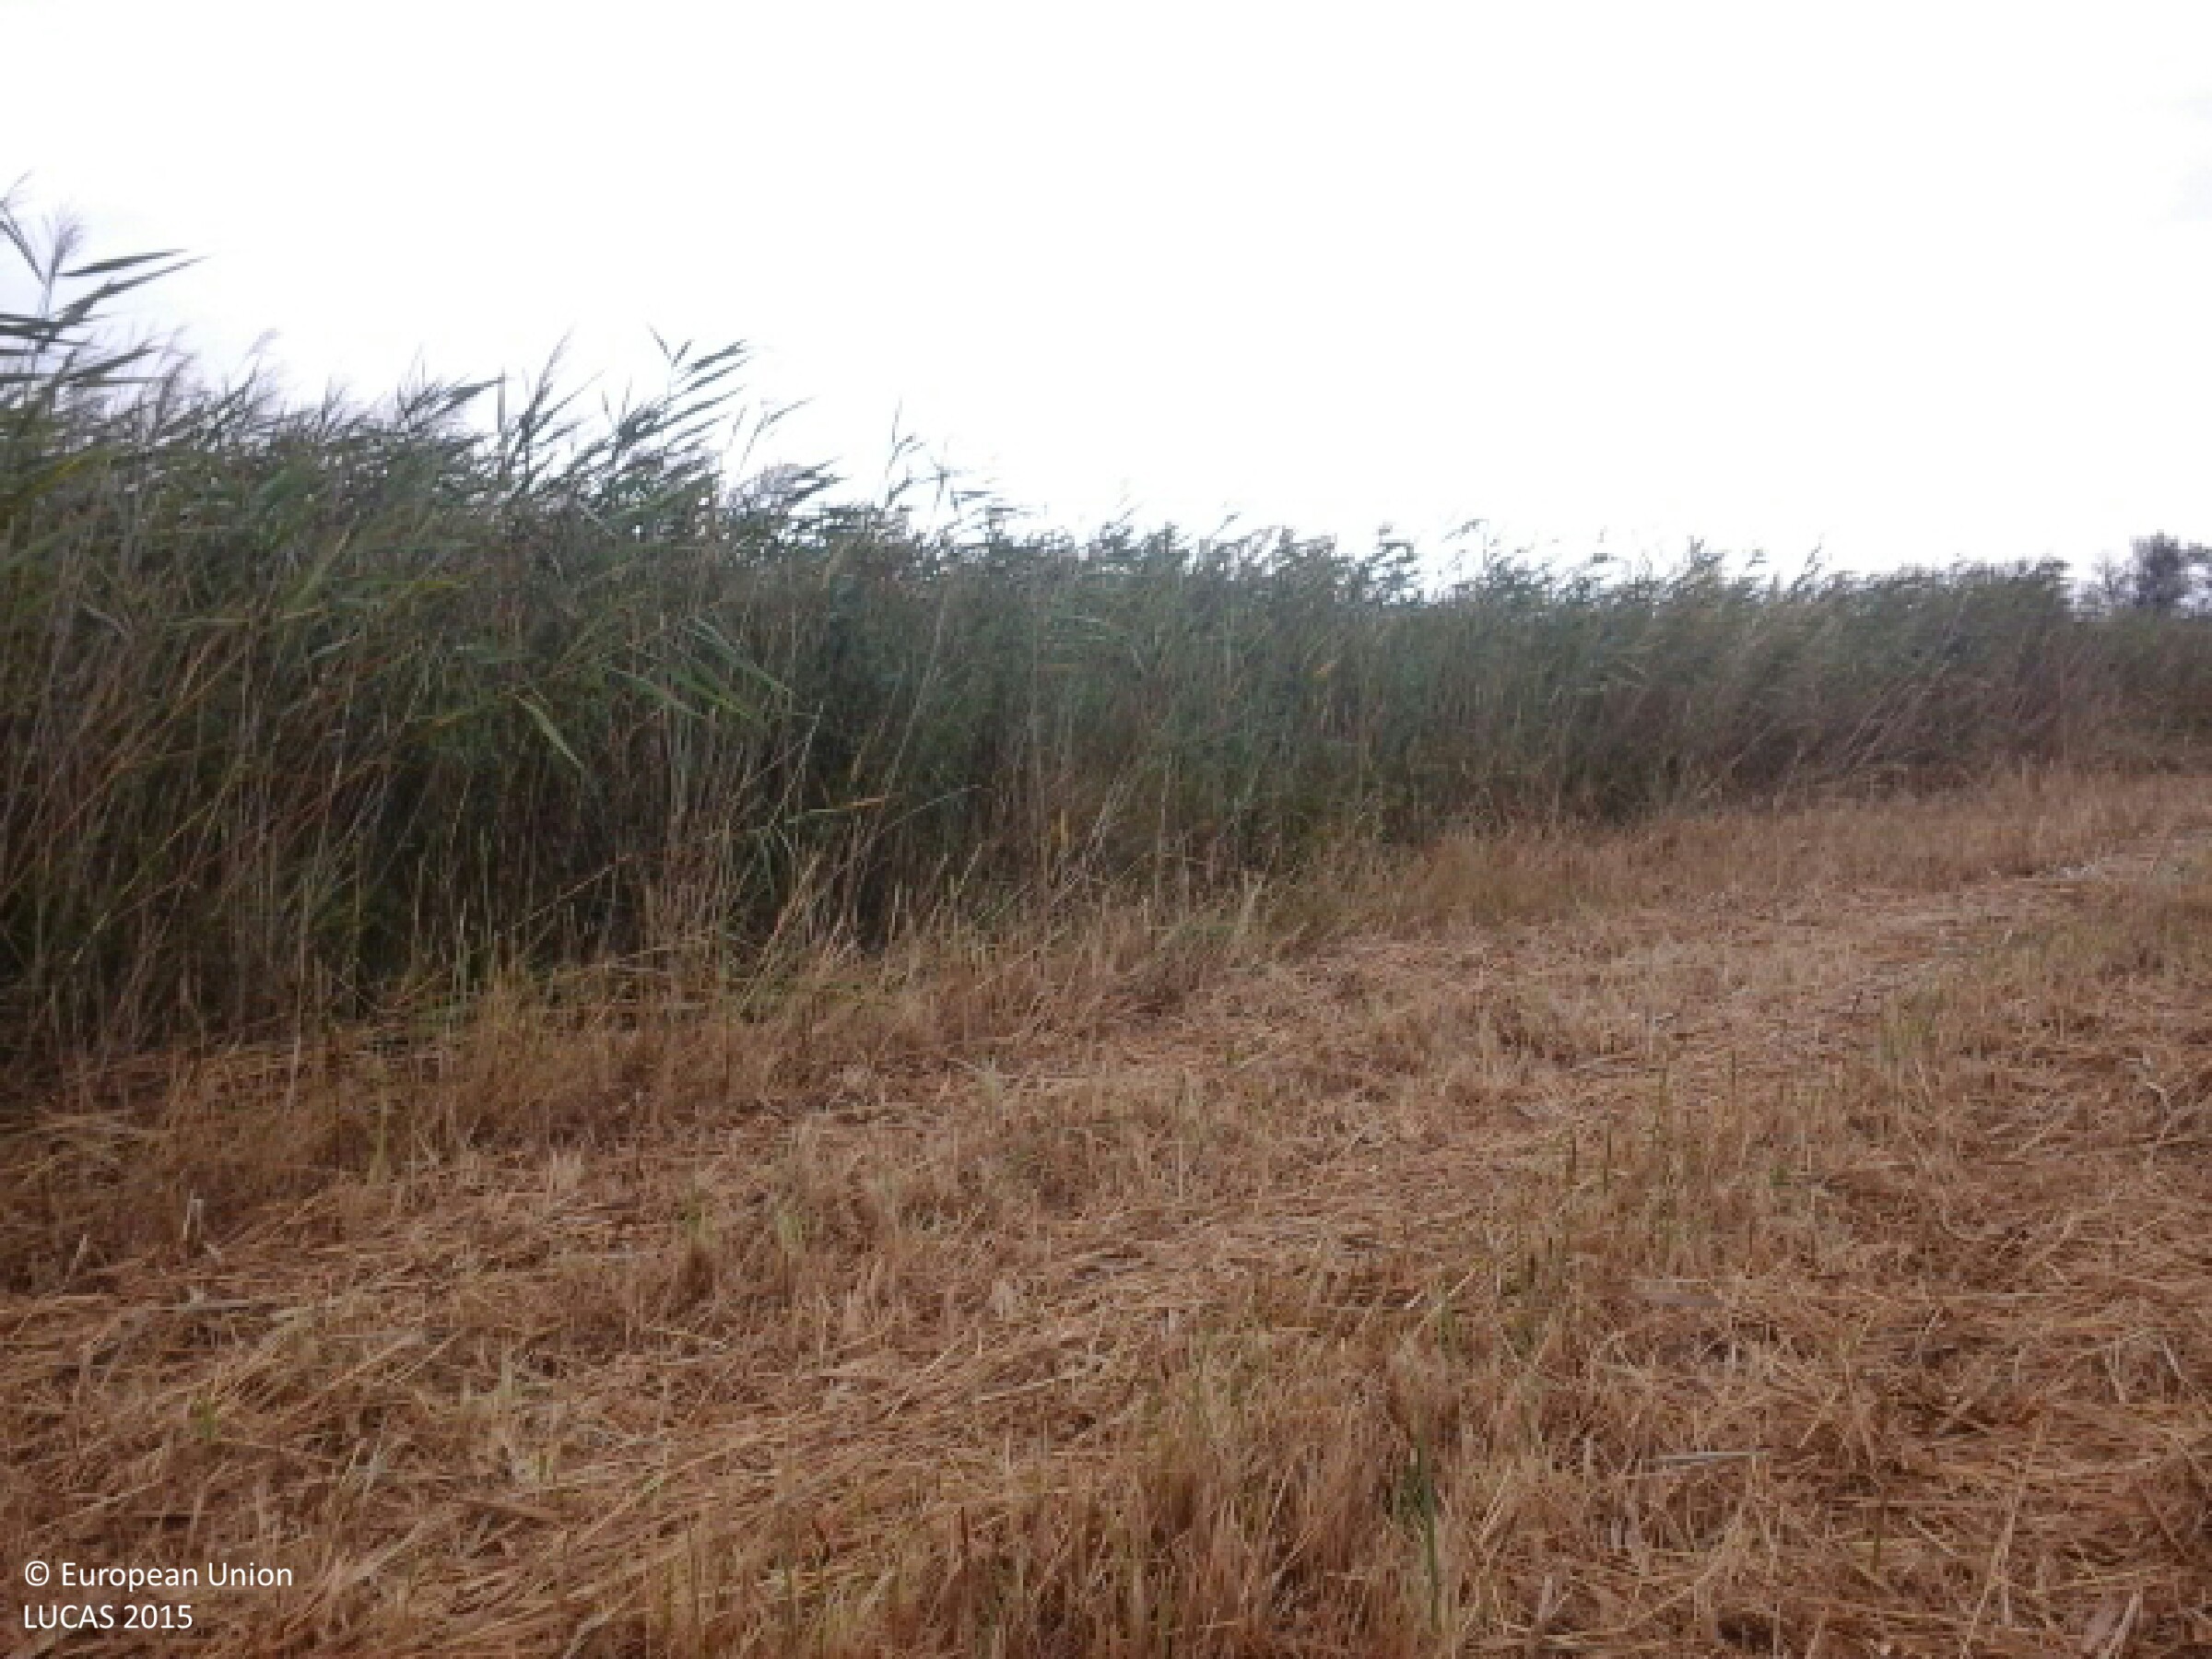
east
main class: Grassland
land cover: Grassland without tree/shrub cover
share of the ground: > 75 %
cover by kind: herbaceous plants 100 %
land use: Agriculture (excluding fallow land and kitchen gardens)
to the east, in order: Grassland without tree/shrub cover; Inland marshes; Grassland without tree/shrub cover
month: August
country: HU
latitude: 48.0390
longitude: 21.4861
